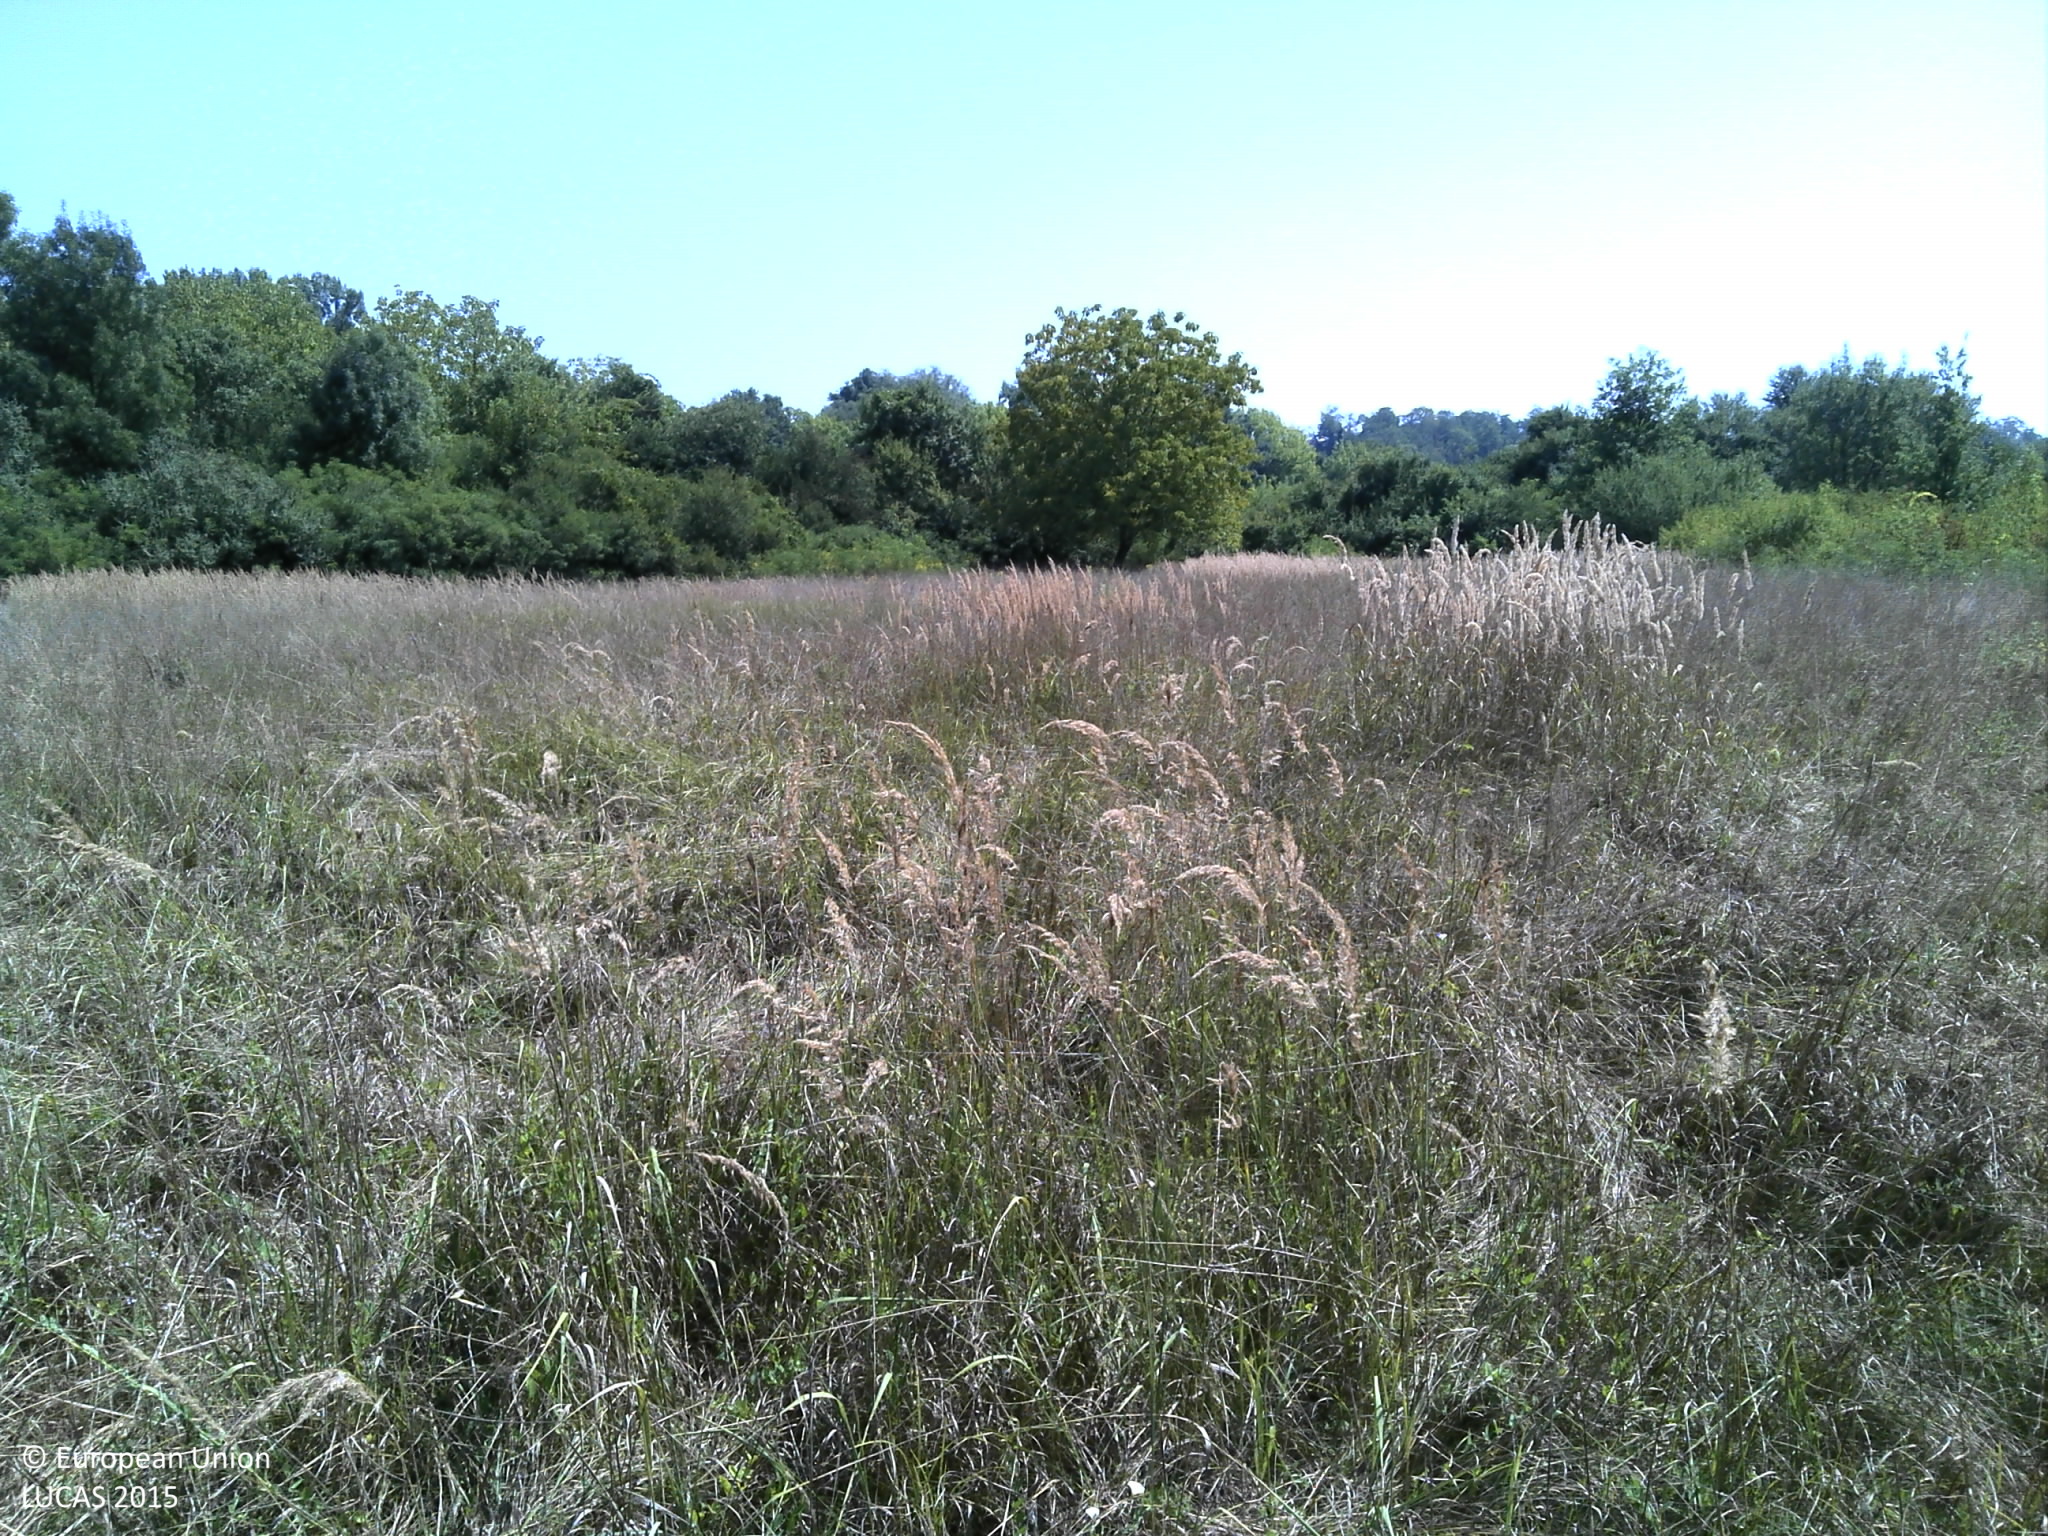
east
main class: Grassland
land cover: Grassland without tree/shrub cover
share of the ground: > 75 %
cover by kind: herbaceous plants 100 %
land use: Agriculture (excluding fallow land and kitchen gardens)
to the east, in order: Grassland without tree/shrub cover; Tracks; Shrubland with sparse tree cover; Spontaneously vegetated surfaces; Maize; Tracks; Other structural elements; Shrubland with sparse tree cover; Rivers and streams
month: August
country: HR
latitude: 45.4755
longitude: 16.3554
